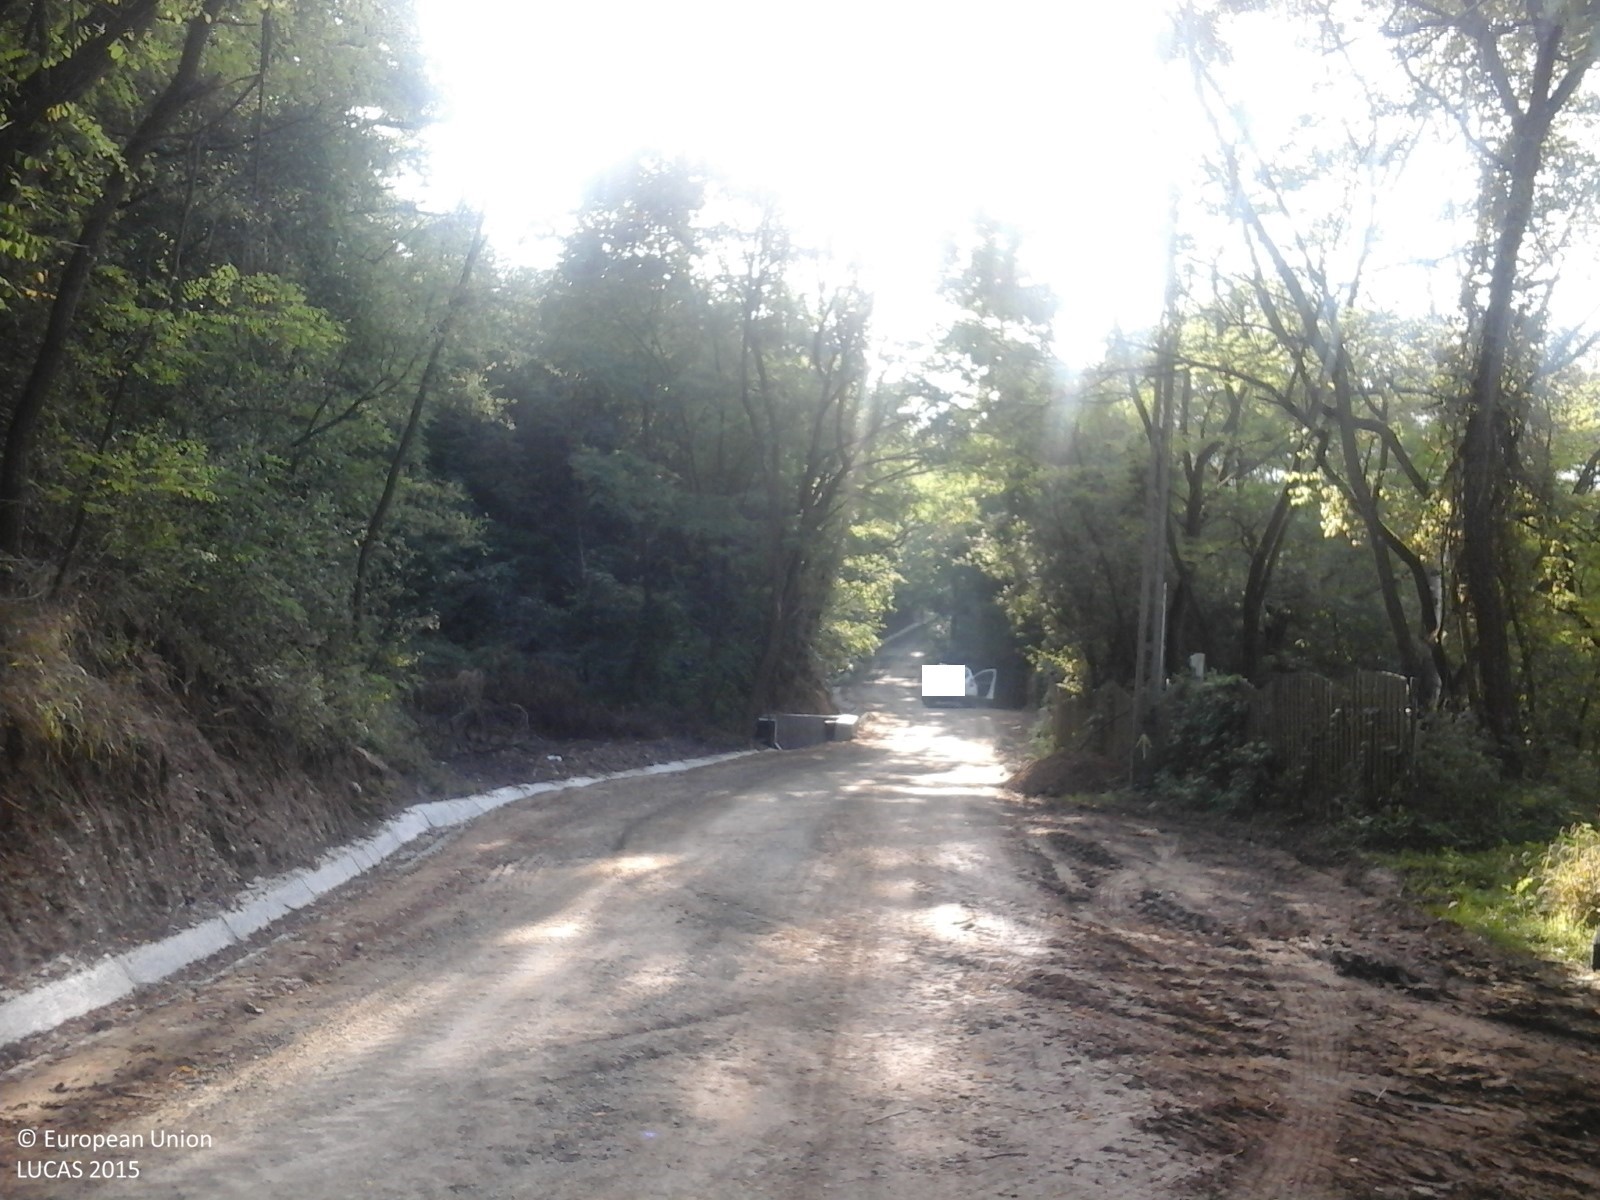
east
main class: Woodland
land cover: Broadleaved woodland
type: beech forest
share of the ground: > 75 %
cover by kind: broadleaved forest trees 100 %
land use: Forestry
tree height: > 5 m
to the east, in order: Tracks; Broadleaved woodland
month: September
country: RO
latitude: 46.7356
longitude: 23.3231
